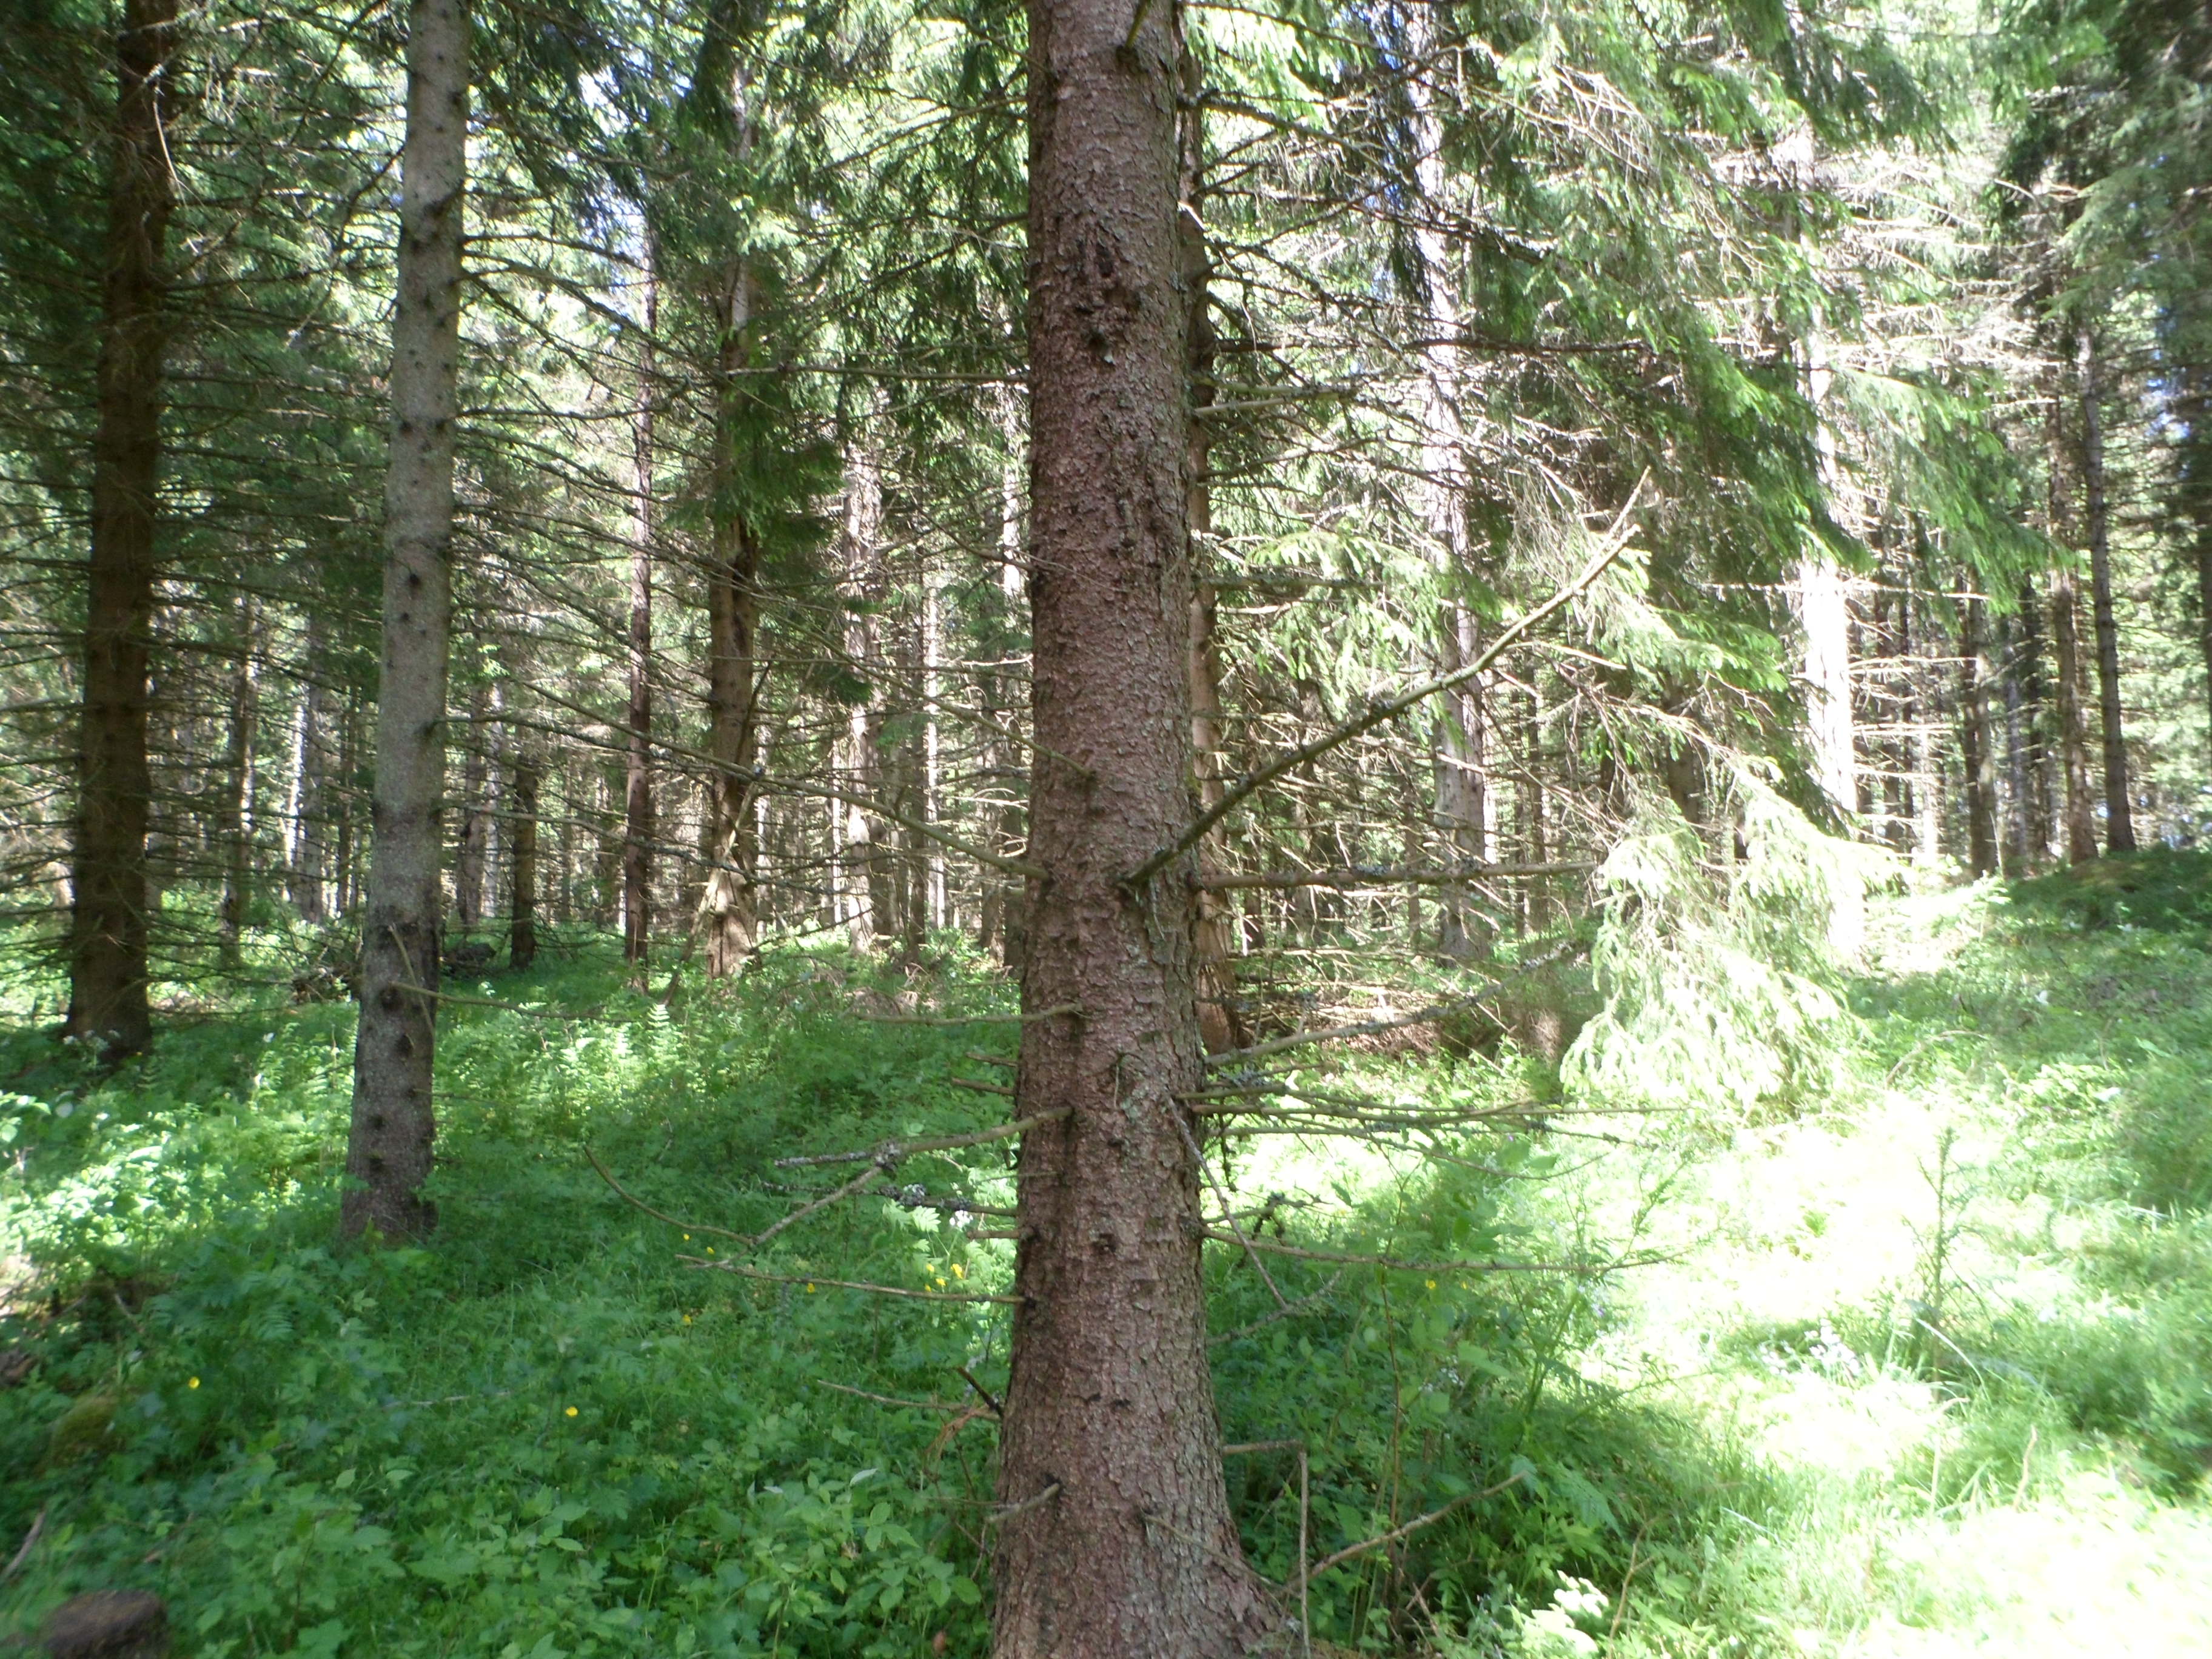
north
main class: Woodland
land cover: Spruce dominated coniferous woodland
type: boreal forest
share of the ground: 50 - 75 %
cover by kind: coniferous forest trees 60 %, herbaceous plants 20 %, shrubs 10 %, broadleaved forest trees 5 %, lichens and mosses 5 %
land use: Forestry
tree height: > 5 m
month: June
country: SE
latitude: 57.5060
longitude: 14.1847
